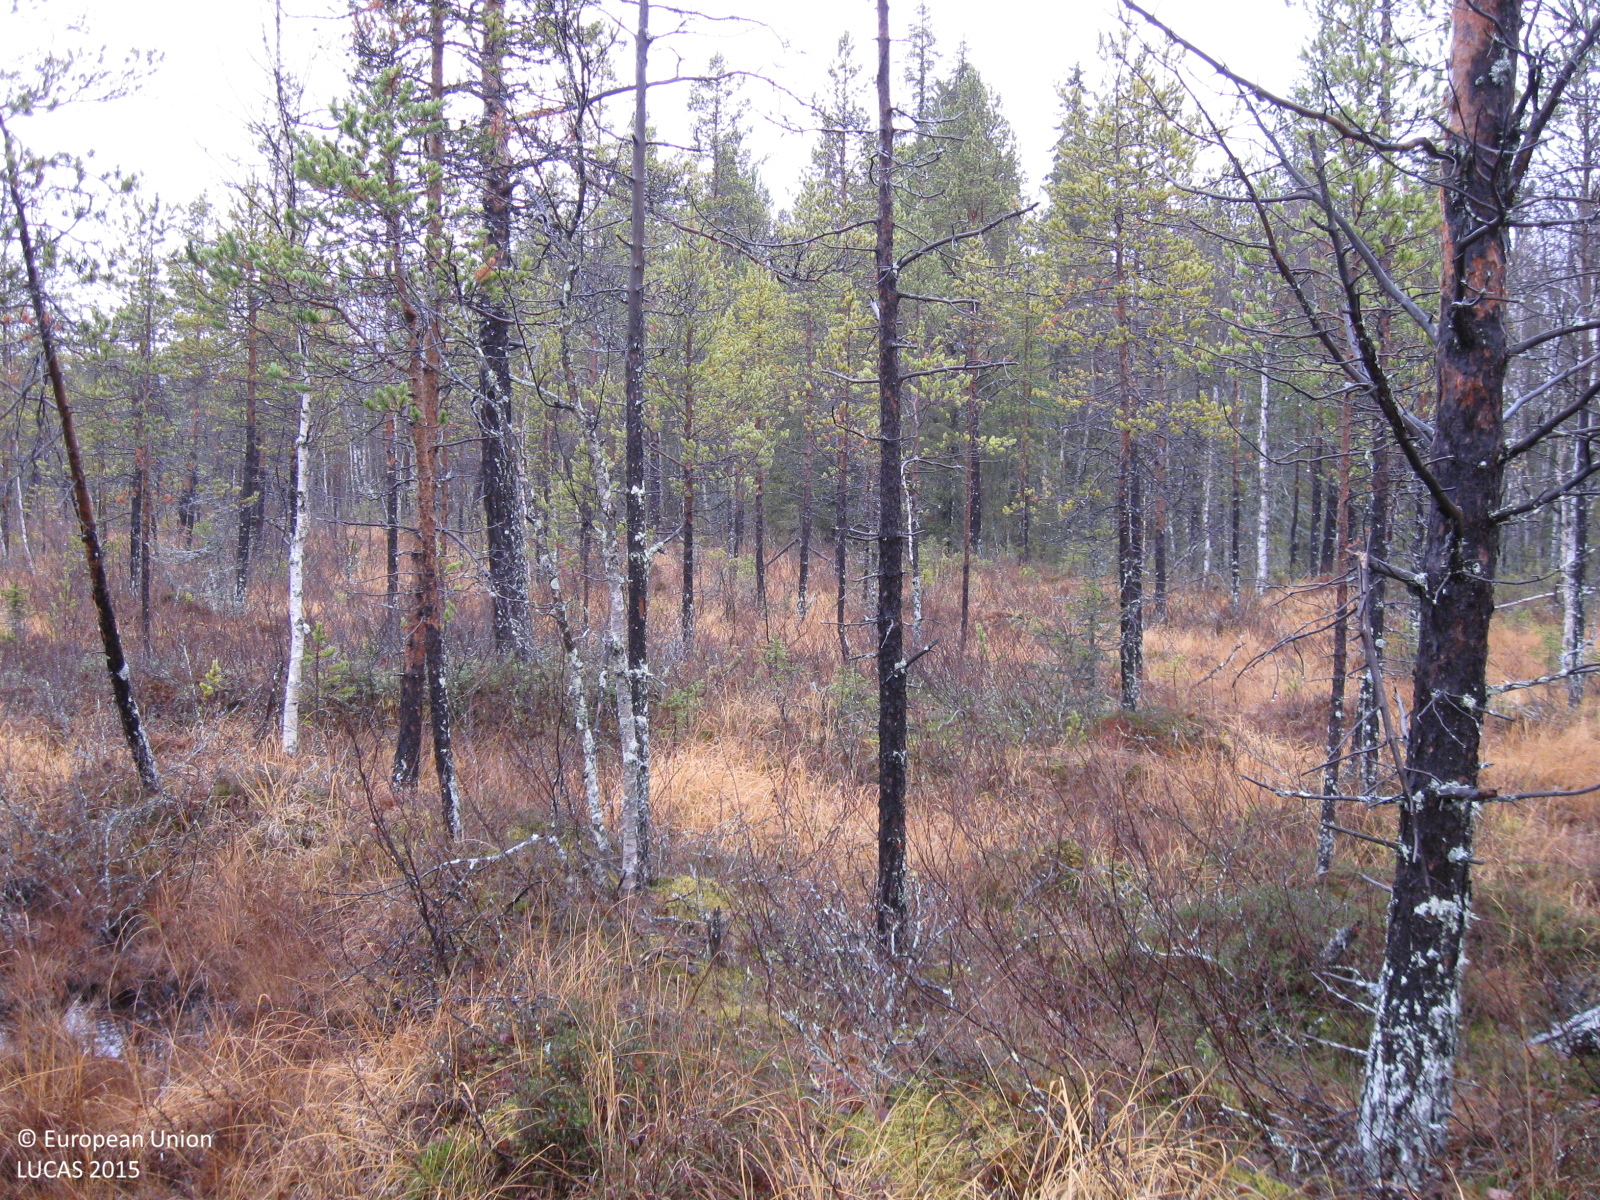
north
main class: Woodland
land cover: Pine dominated mixed woodland
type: mire and swamp forests
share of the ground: 50 - 75 %
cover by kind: coniferous forest trees 40 %, shrubs 25 %, broadleaved forest trees 20 %, herbaceous plants 10 %, lichens and mosses 5 %
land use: Forestry
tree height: > 5 m
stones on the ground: < 10 %
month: October
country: SE
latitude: 66.5738
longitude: 21.0258
